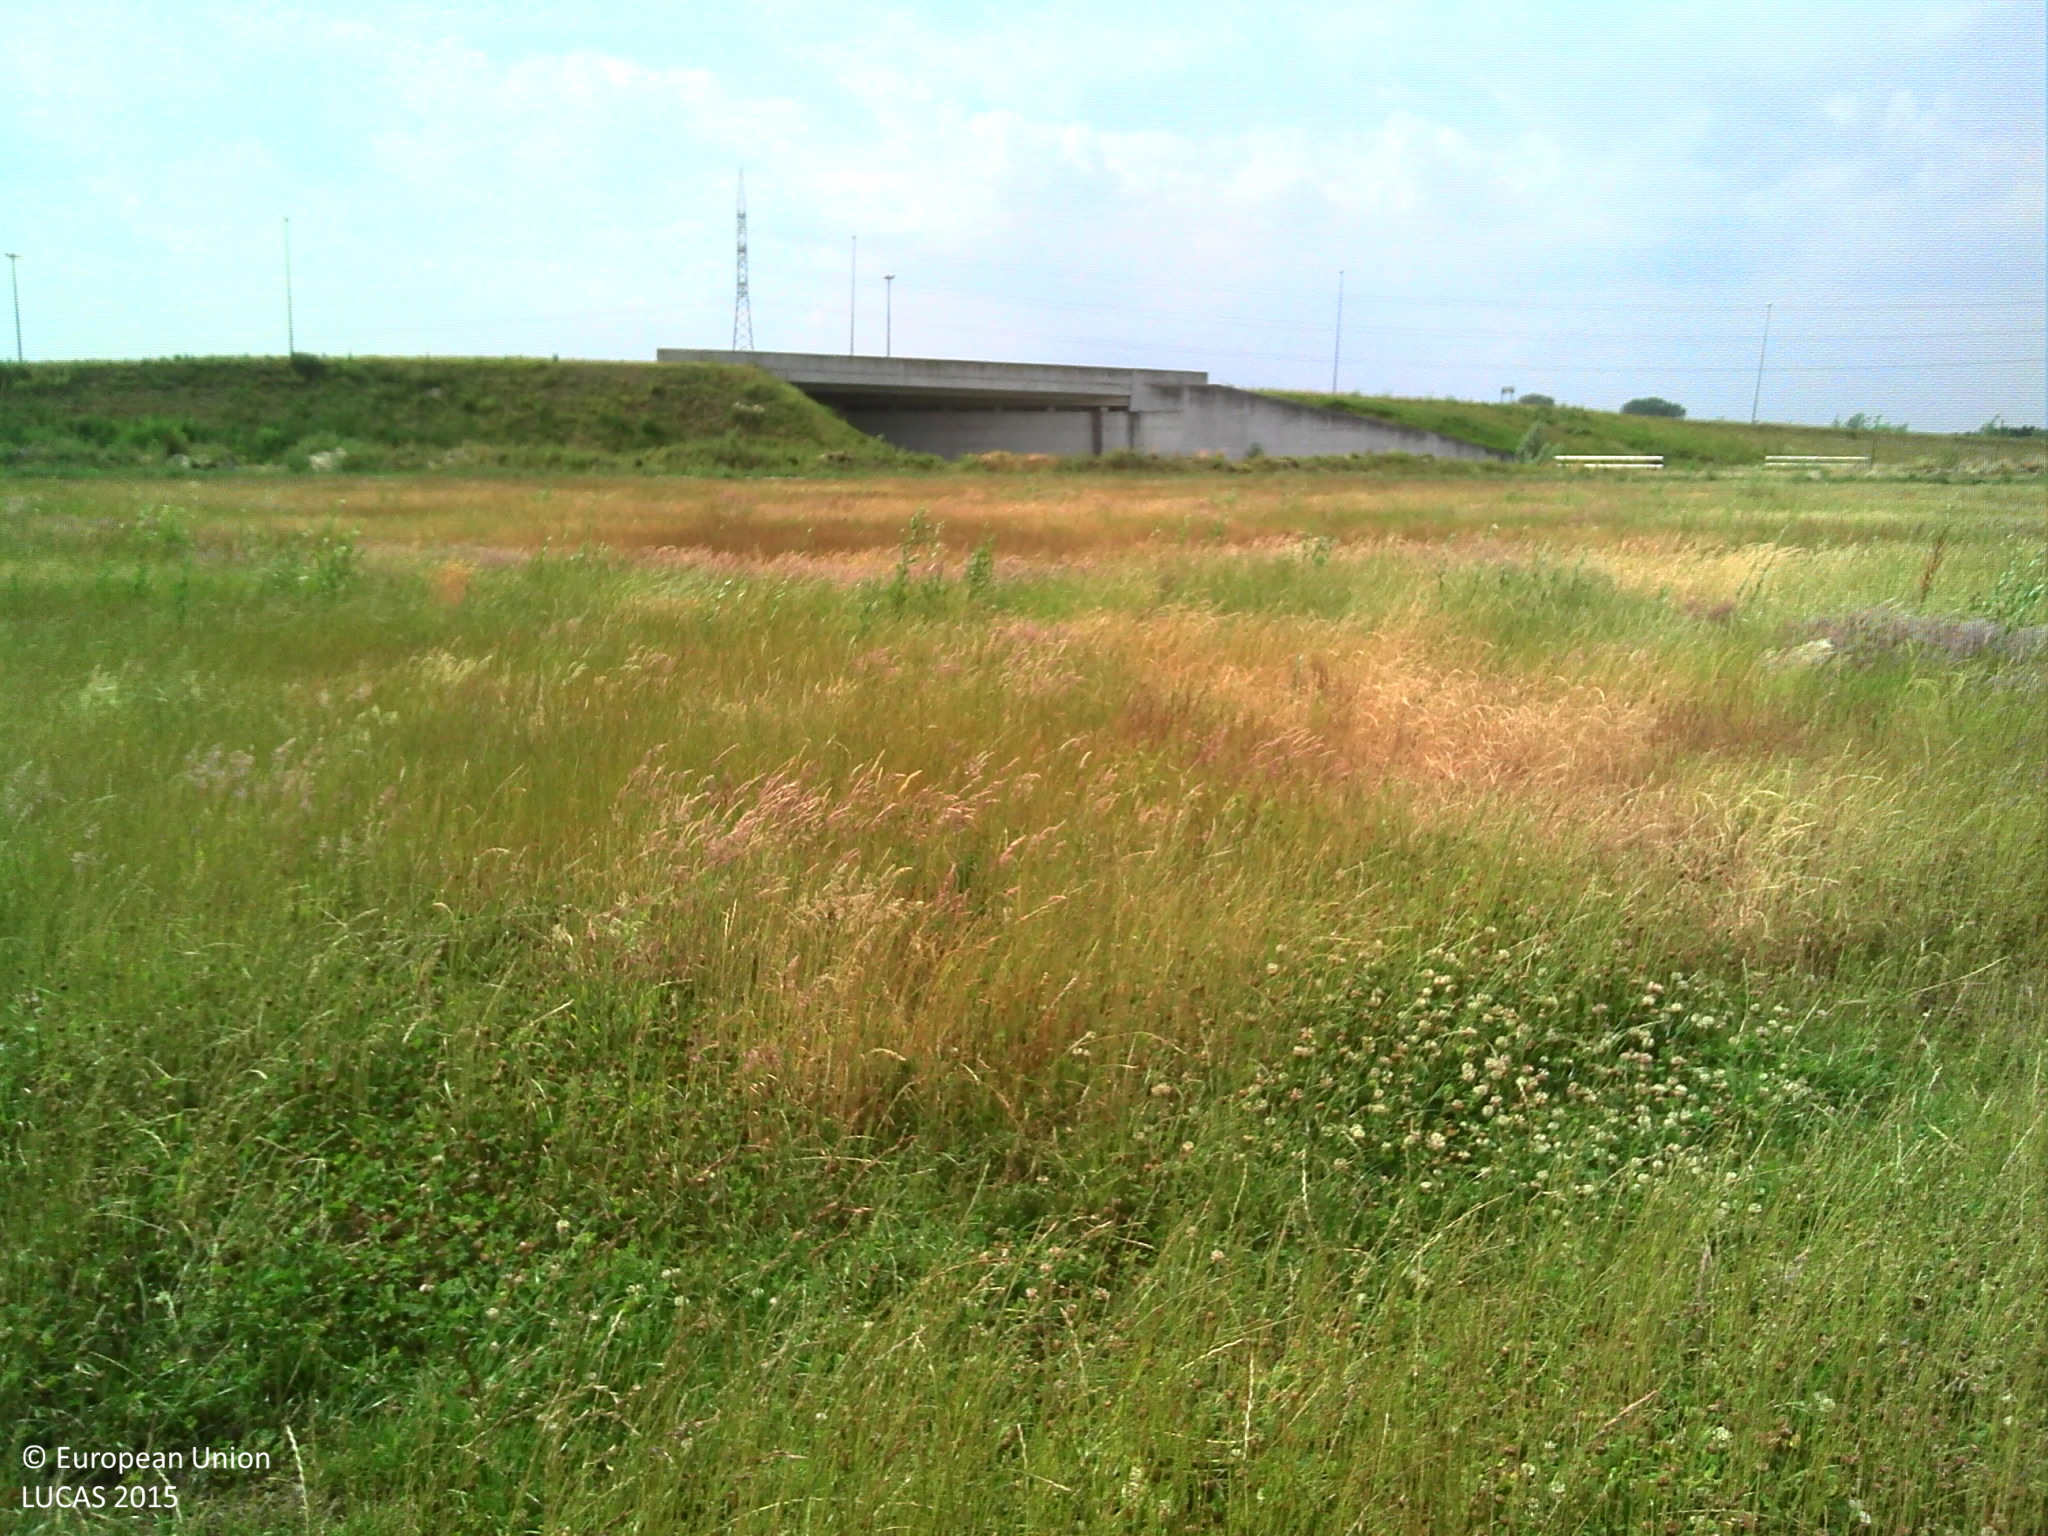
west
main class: Grassland
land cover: Grassland without tree/shrub cover
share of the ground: > 75 %
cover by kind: herbaceous plants 100 %
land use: Semi-natural and natural areas not in use
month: June
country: BE
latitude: 51.1487
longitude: 3.7460
